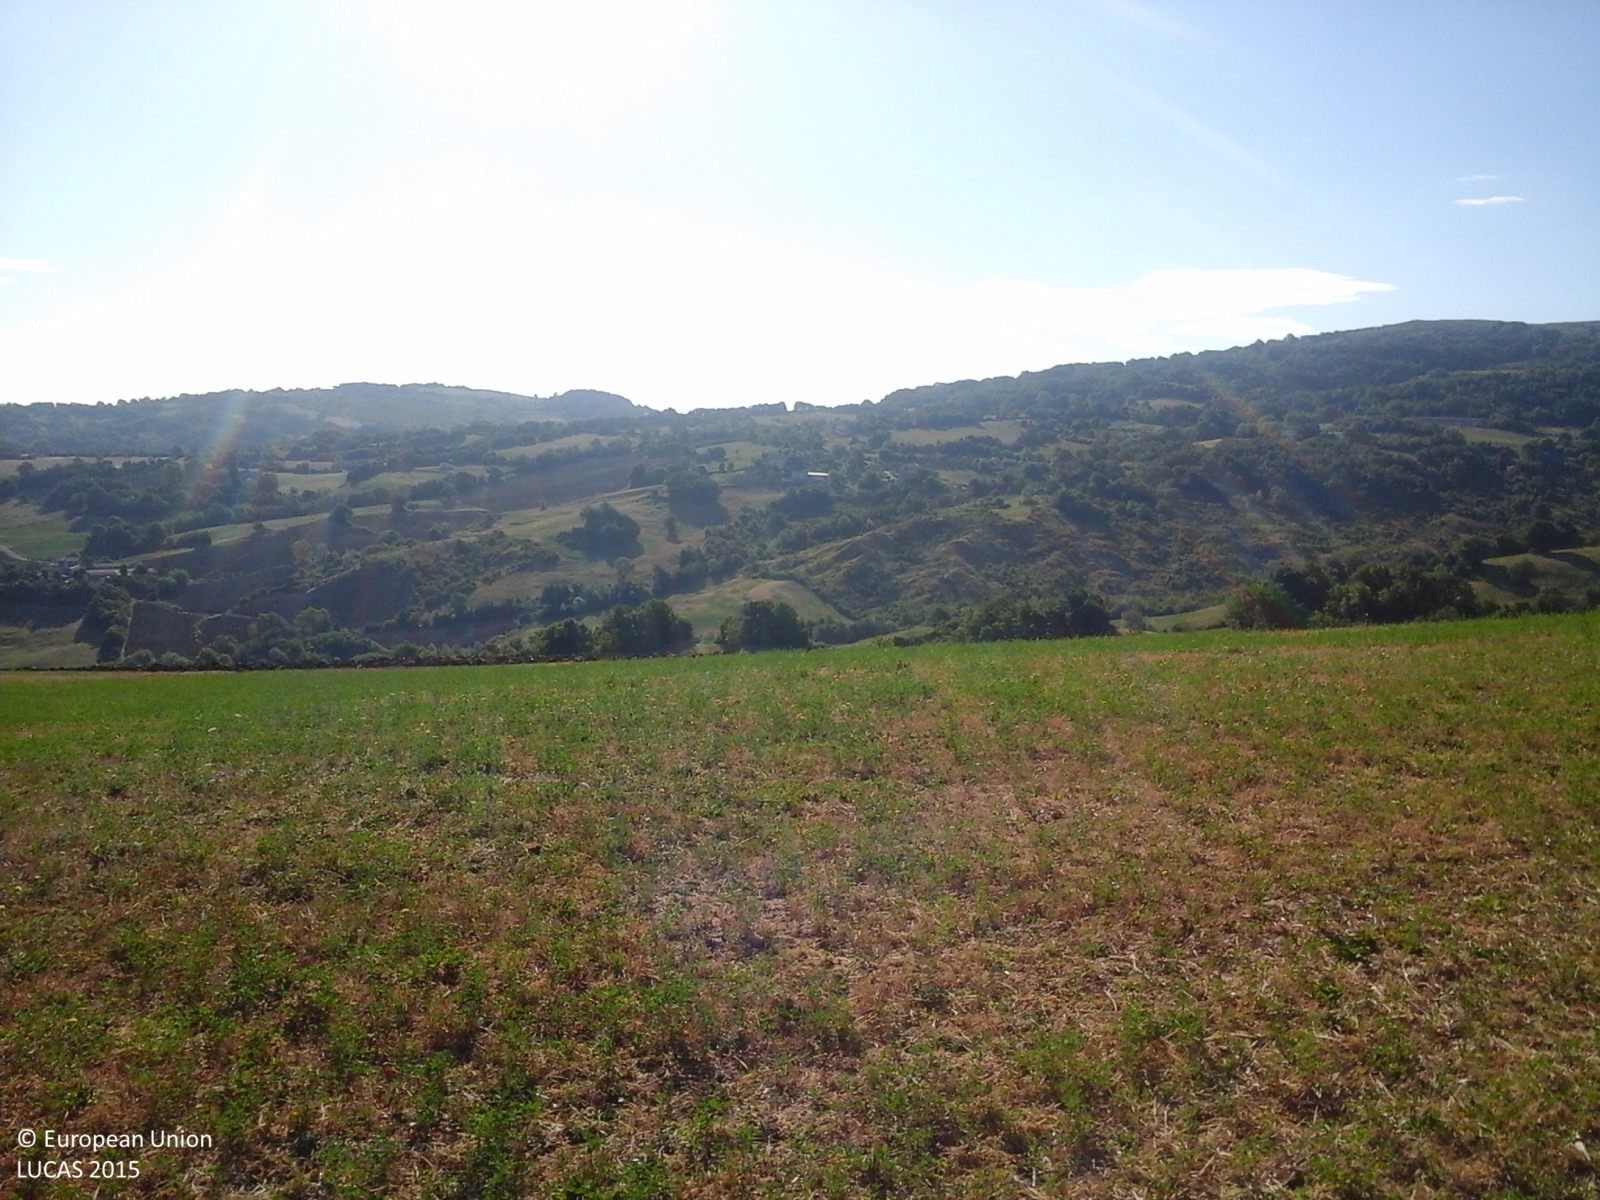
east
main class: Cropland
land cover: Lucerne
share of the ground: > 75 %
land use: Agriculture (excluding fallow land and kitchen gardens)
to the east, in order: Lucerne; Other bare soil; Shrubland without tree cover
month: July
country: IT
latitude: 43.8892
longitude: 12.4215
